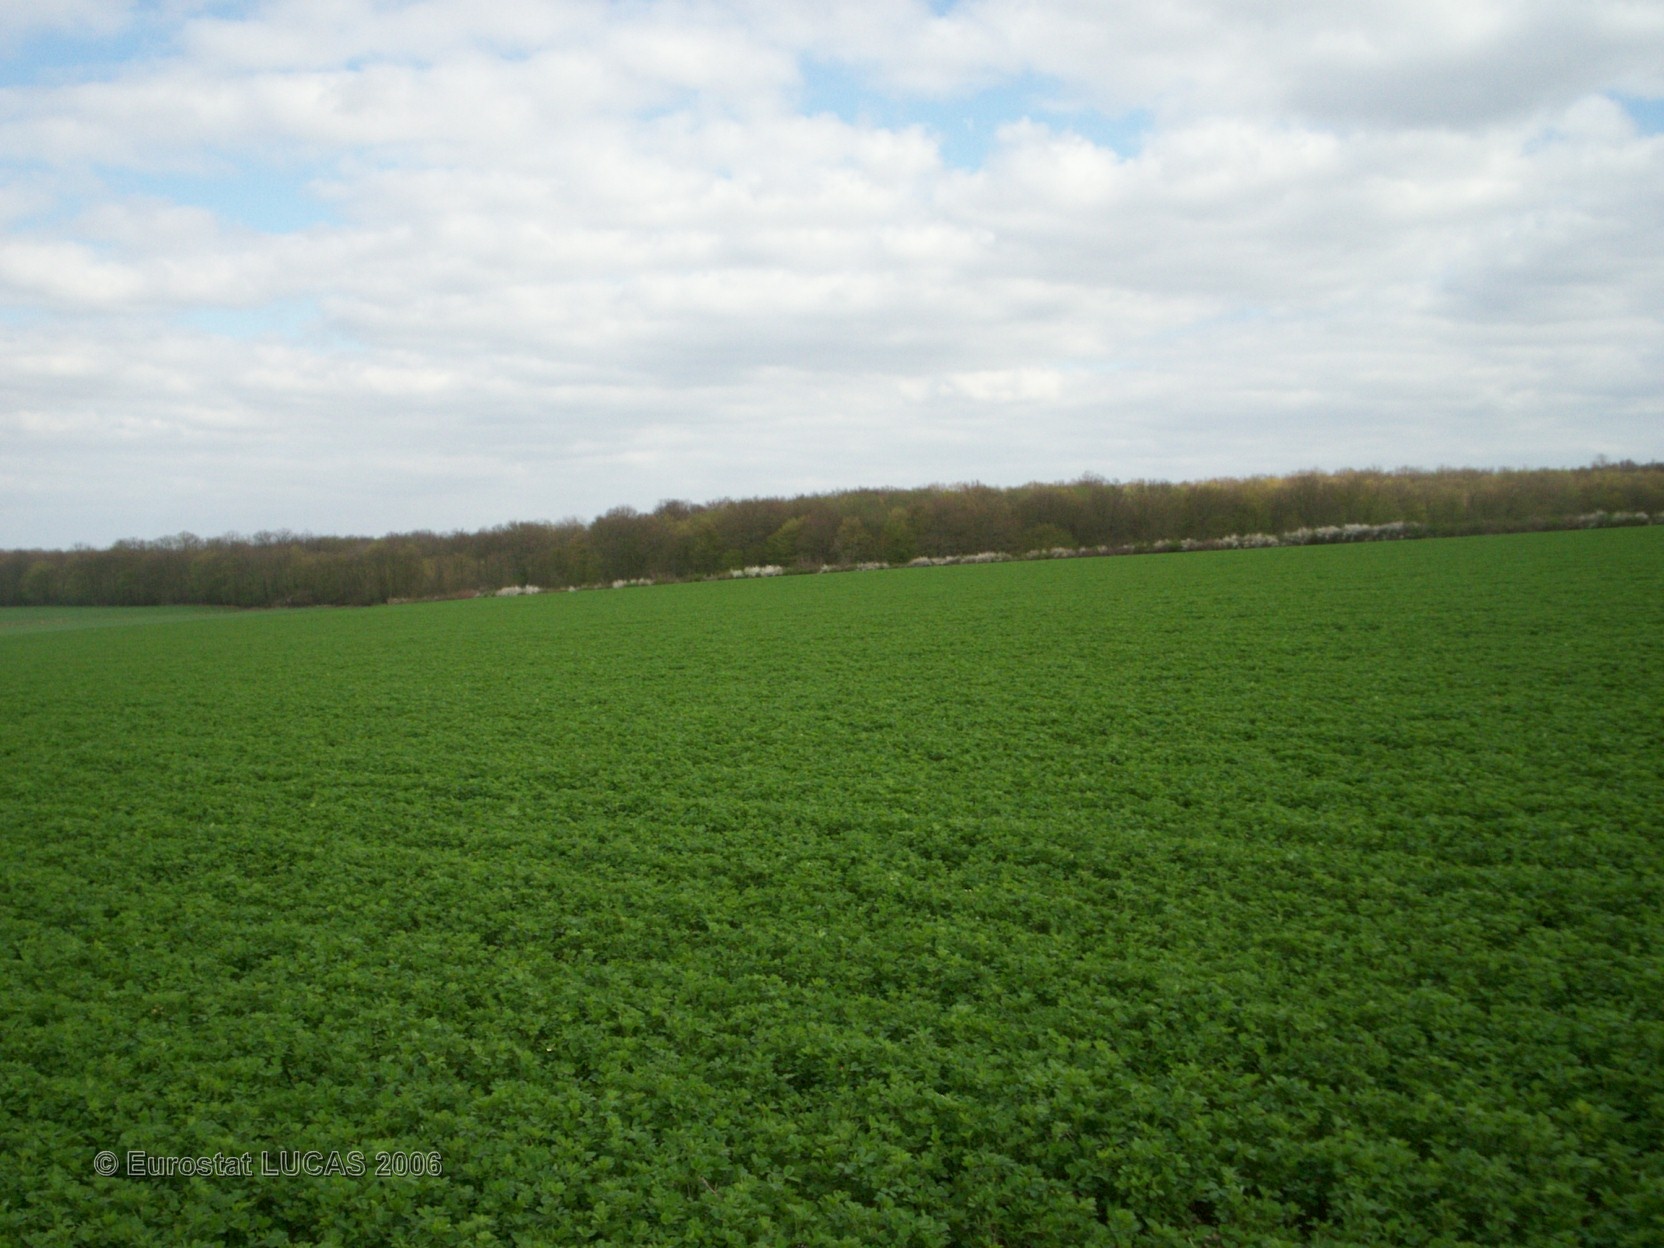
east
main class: Cropland
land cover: Lucerne
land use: Agriculture (excluding fallow land and kitchen gardens)
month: April
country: FR
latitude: 48.4474
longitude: 2.9208
